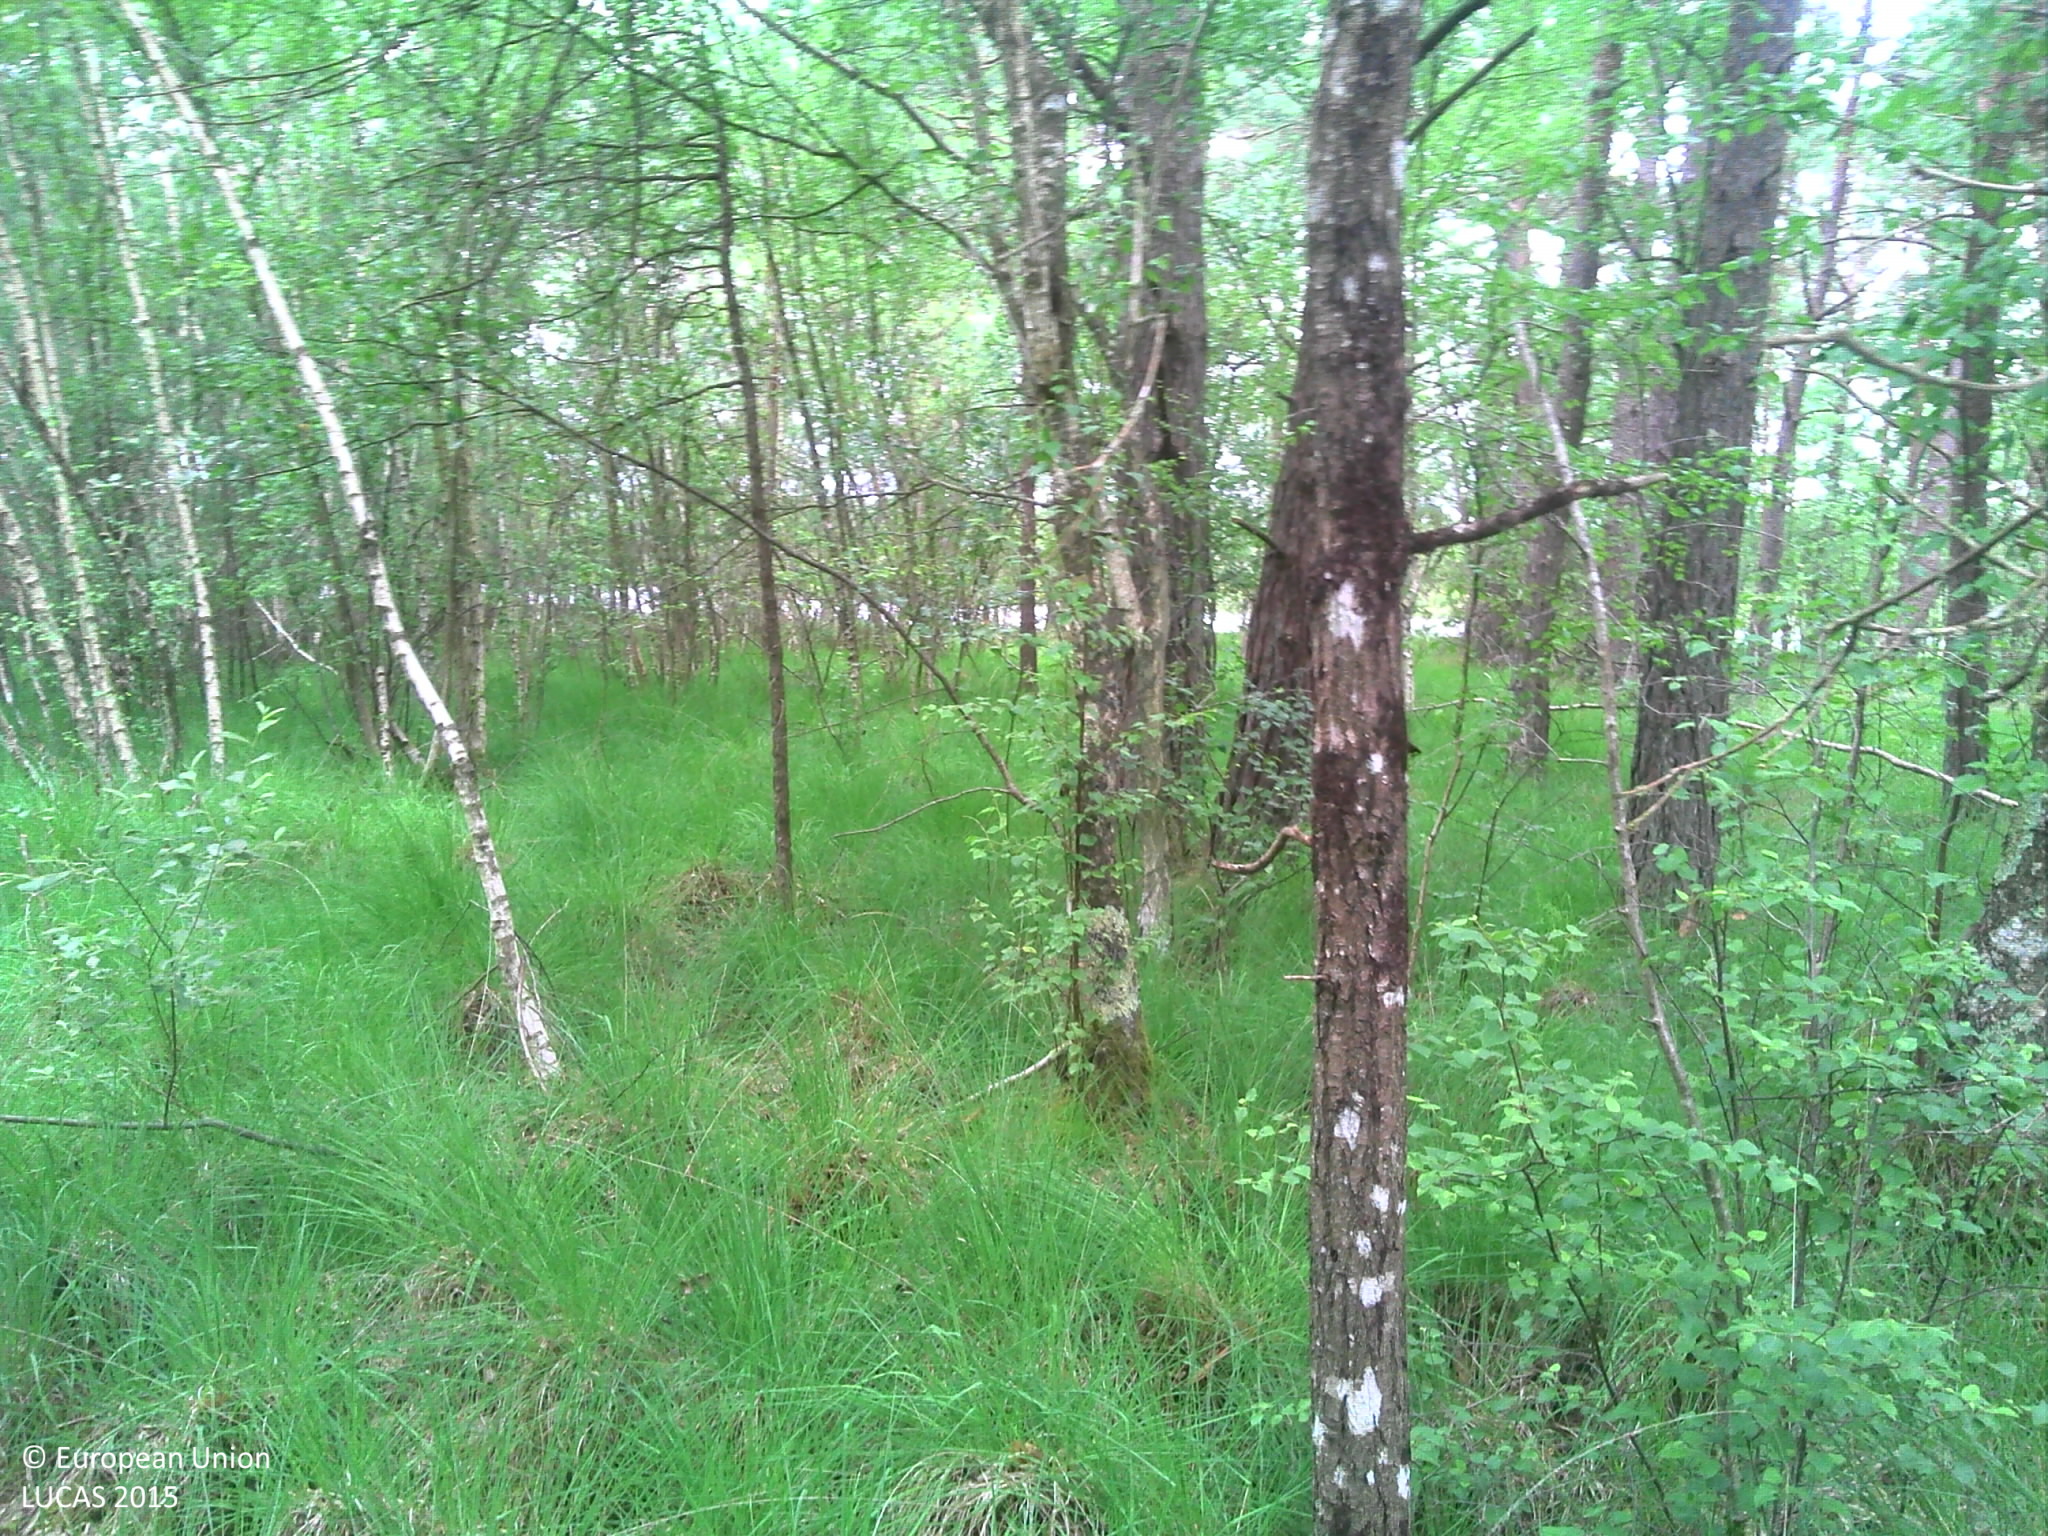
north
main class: Woodland
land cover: Pine dominated mixed woodland
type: thermophilous deciduous forest
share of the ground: > 75 %
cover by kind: herbaceous plants 60 %, coniferous forest trees 15 %, broadleaved forest trees 15 %, lichens and mosses 10 %
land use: Amenities, museums, leisure
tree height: > 5 m
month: June
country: FR
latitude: 47.5211
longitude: 2.0611
